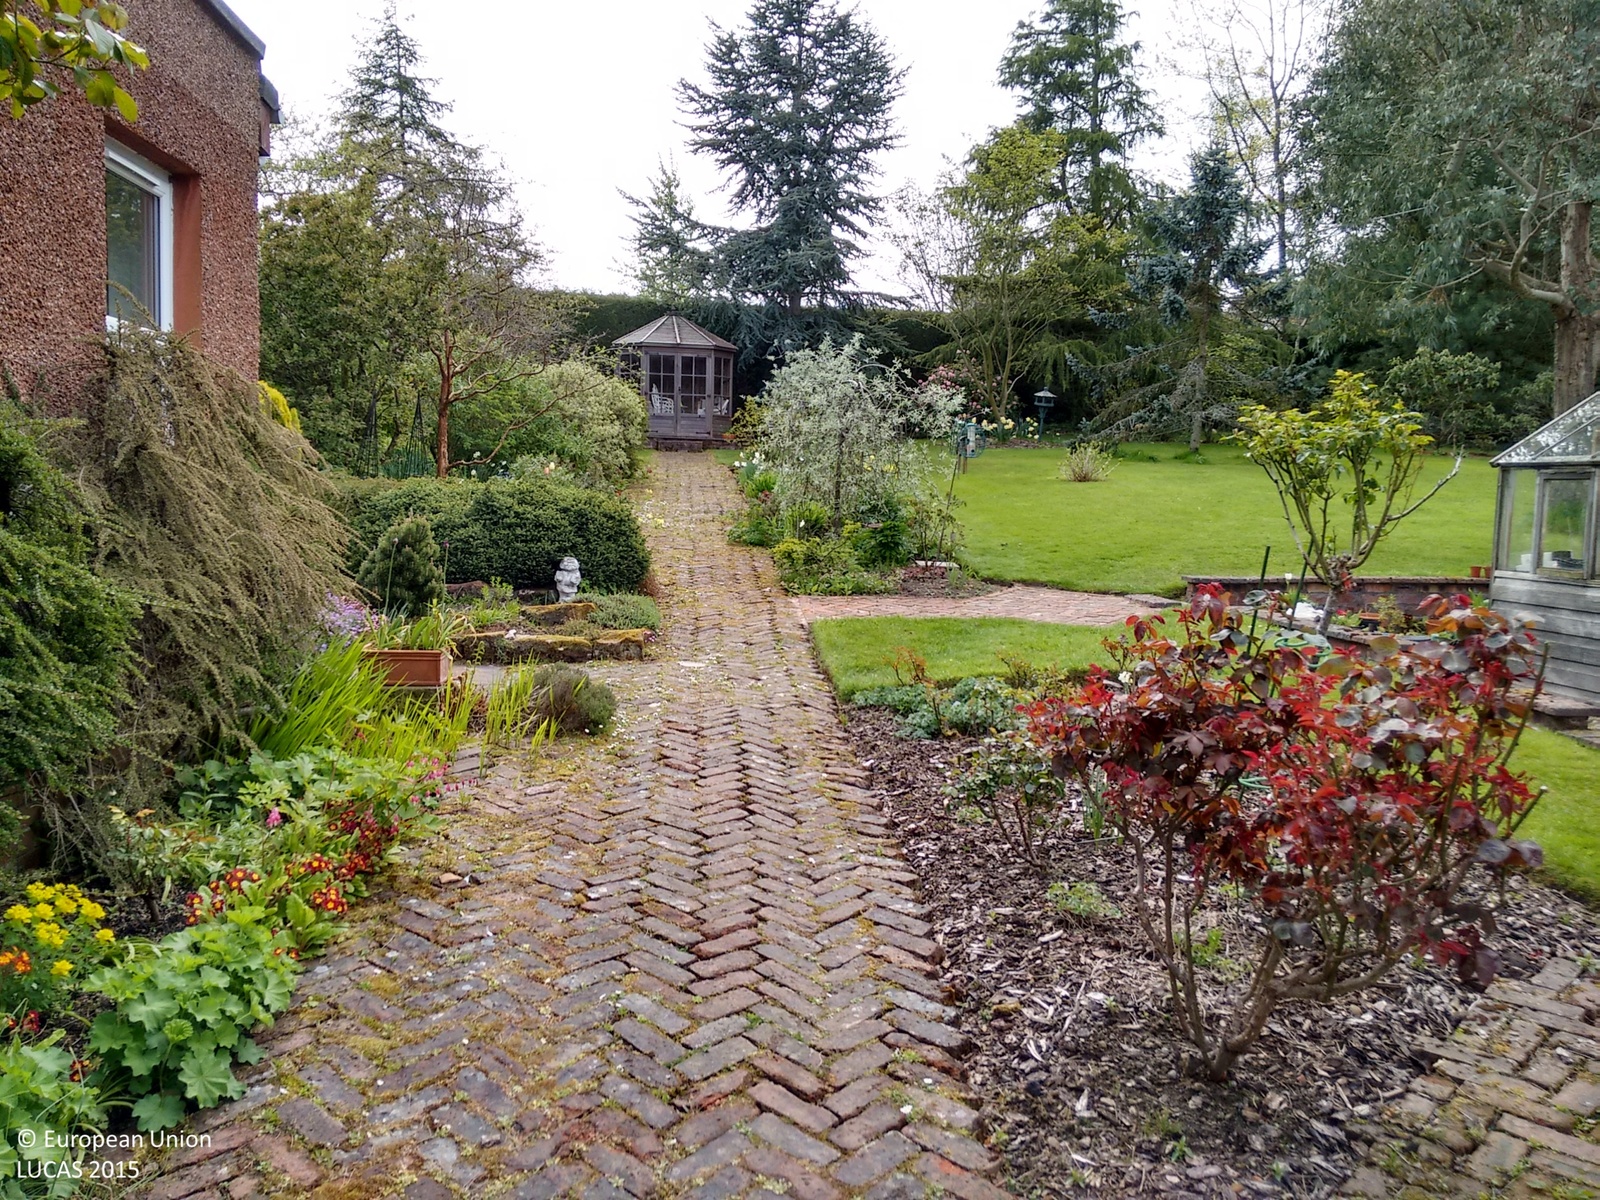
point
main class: Grassland
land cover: Grassland with sparse tree/shrub cover
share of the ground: > 75 %
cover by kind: herbaceous plants 75 %, consolidated bare surface 15 %, broadleaved forest trees 5 %, shrubs 5 %
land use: Residential
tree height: > 5 m
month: May
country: GB
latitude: 55.8931
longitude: -3.2979
